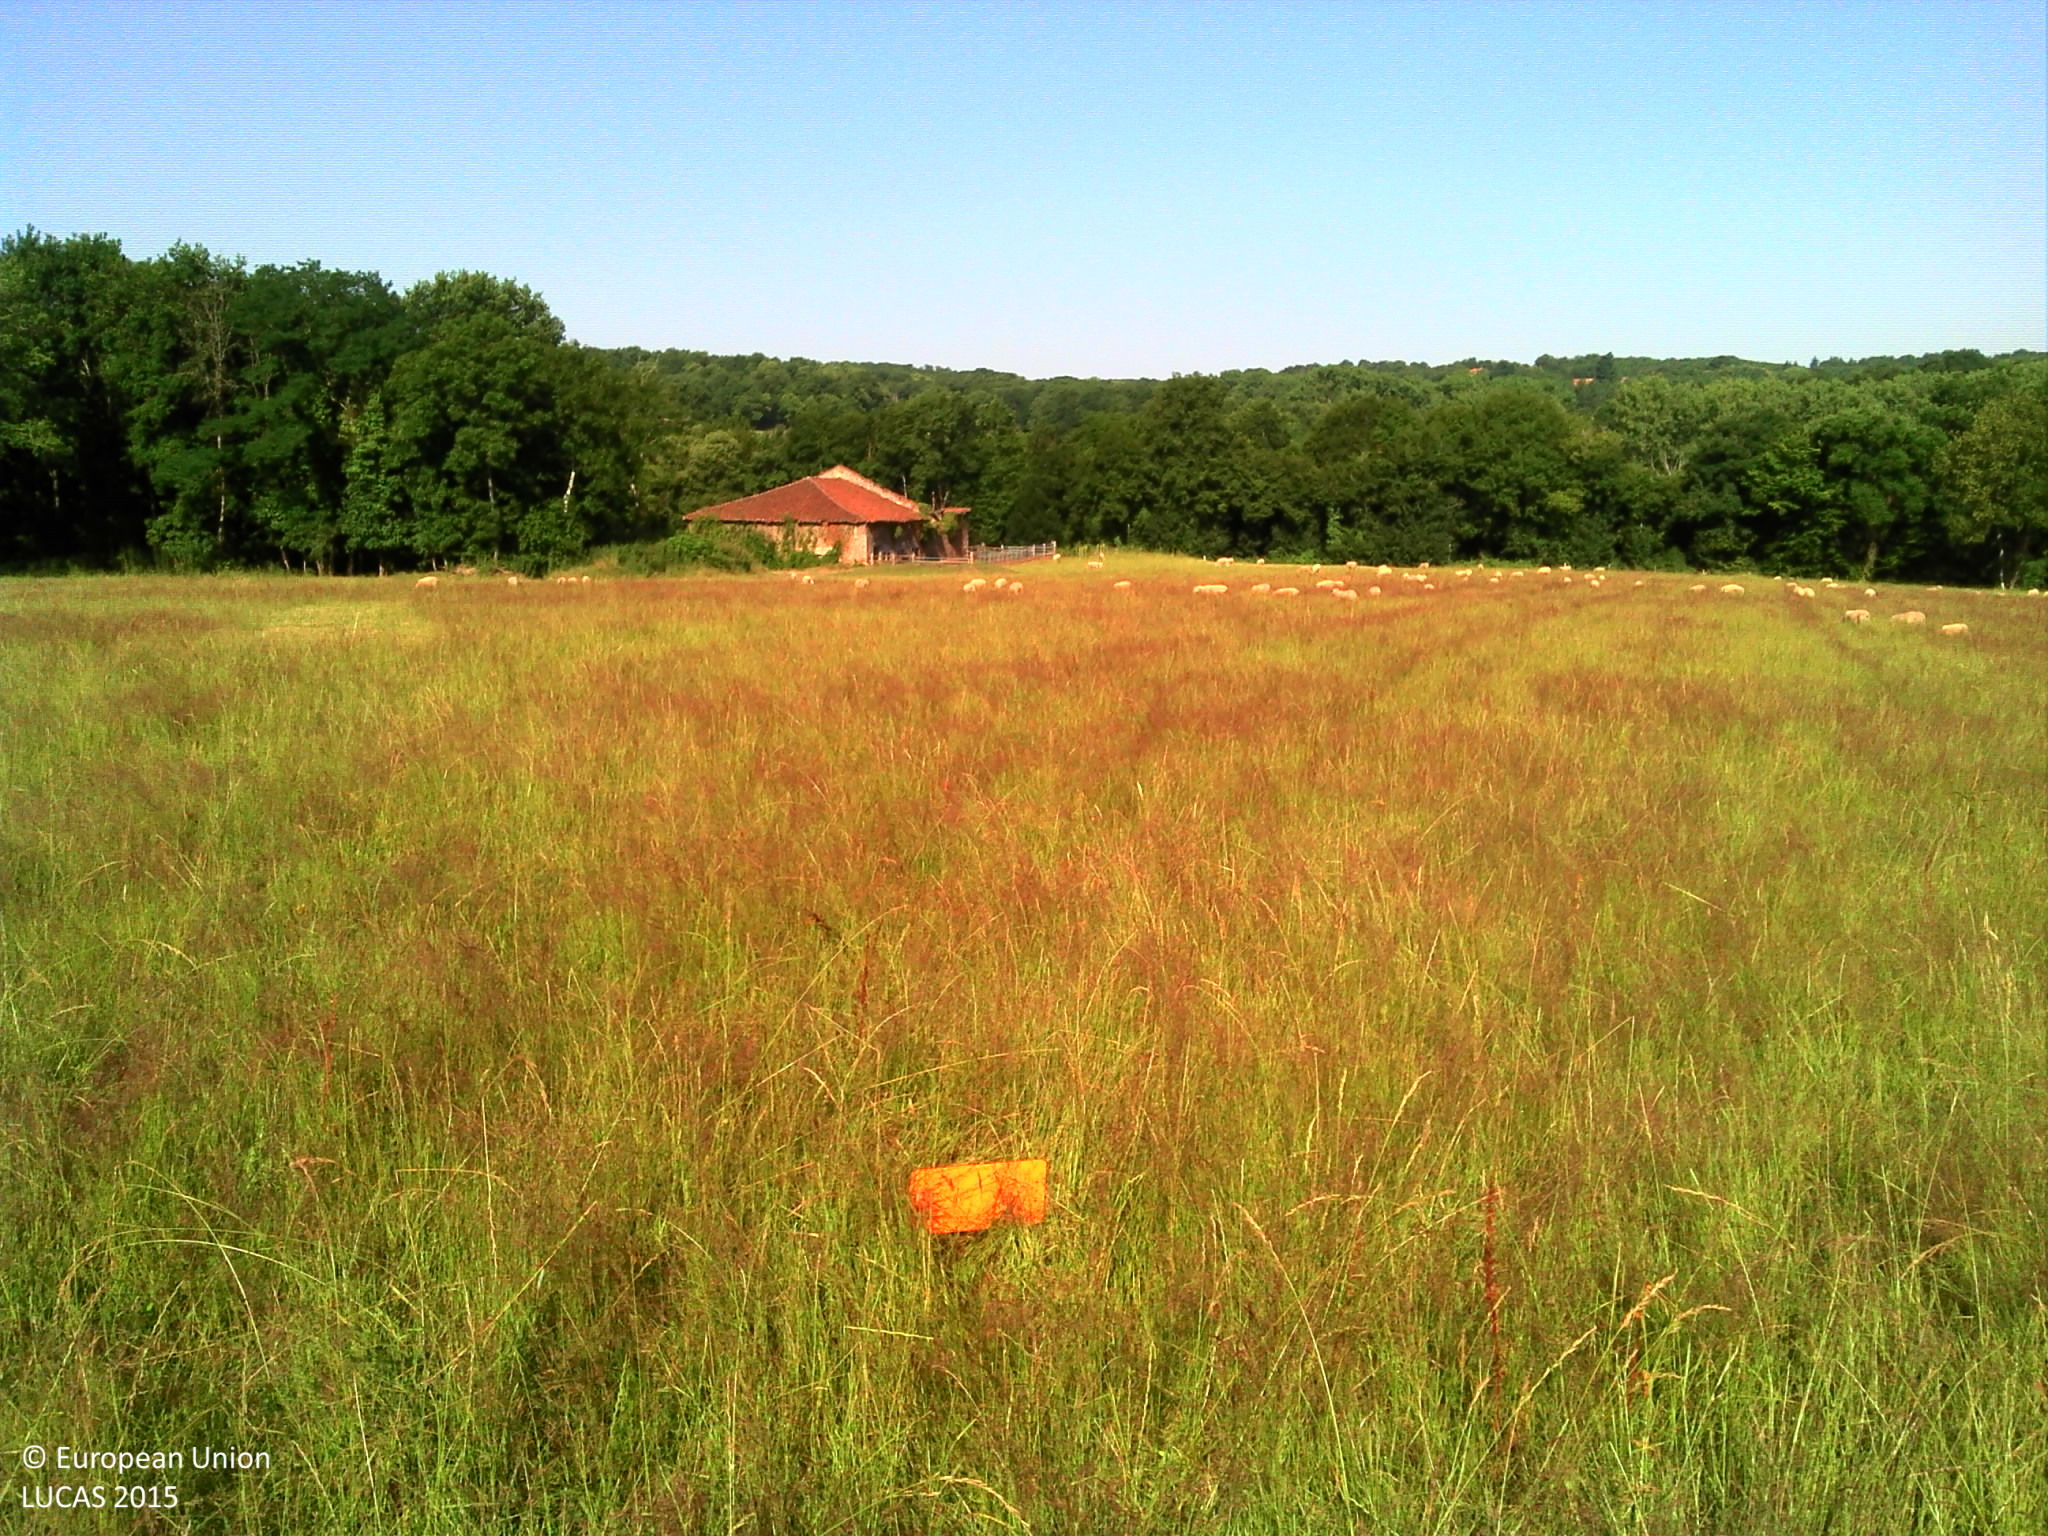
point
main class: Grassland
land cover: Grassland without tree/shrub cover
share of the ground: > 75 %
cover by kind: herbaceous plants 100 %
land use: Agriculture (excluding fallow land and kitchen gardens)
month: June
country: FR
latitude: 45.9217
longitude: 0.6378
